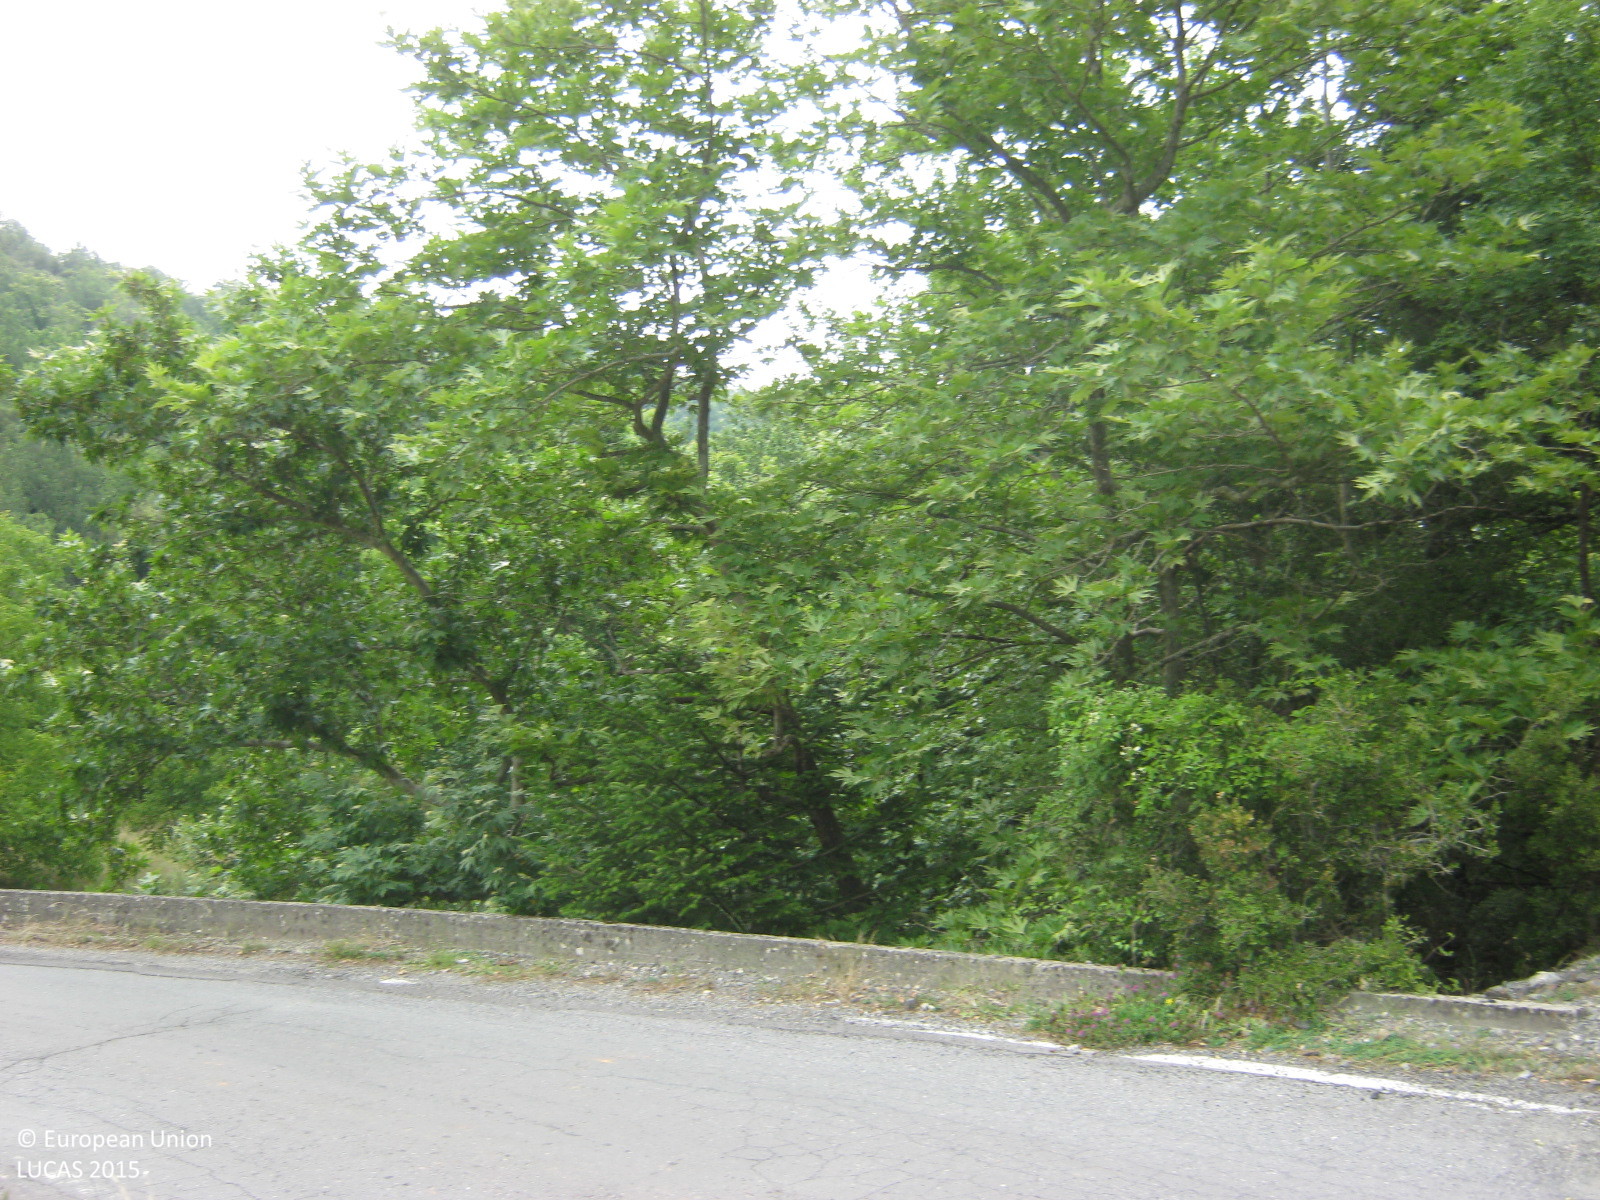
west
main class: Shrubland
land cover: Shrubland without tree cover
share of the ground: > 75 %
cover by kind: shrubs 55 %, herbaceous plants 45 %
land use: Semi-natural and natural areas not in use
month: July
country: GR
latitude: 37.3258
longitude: 22.4754
